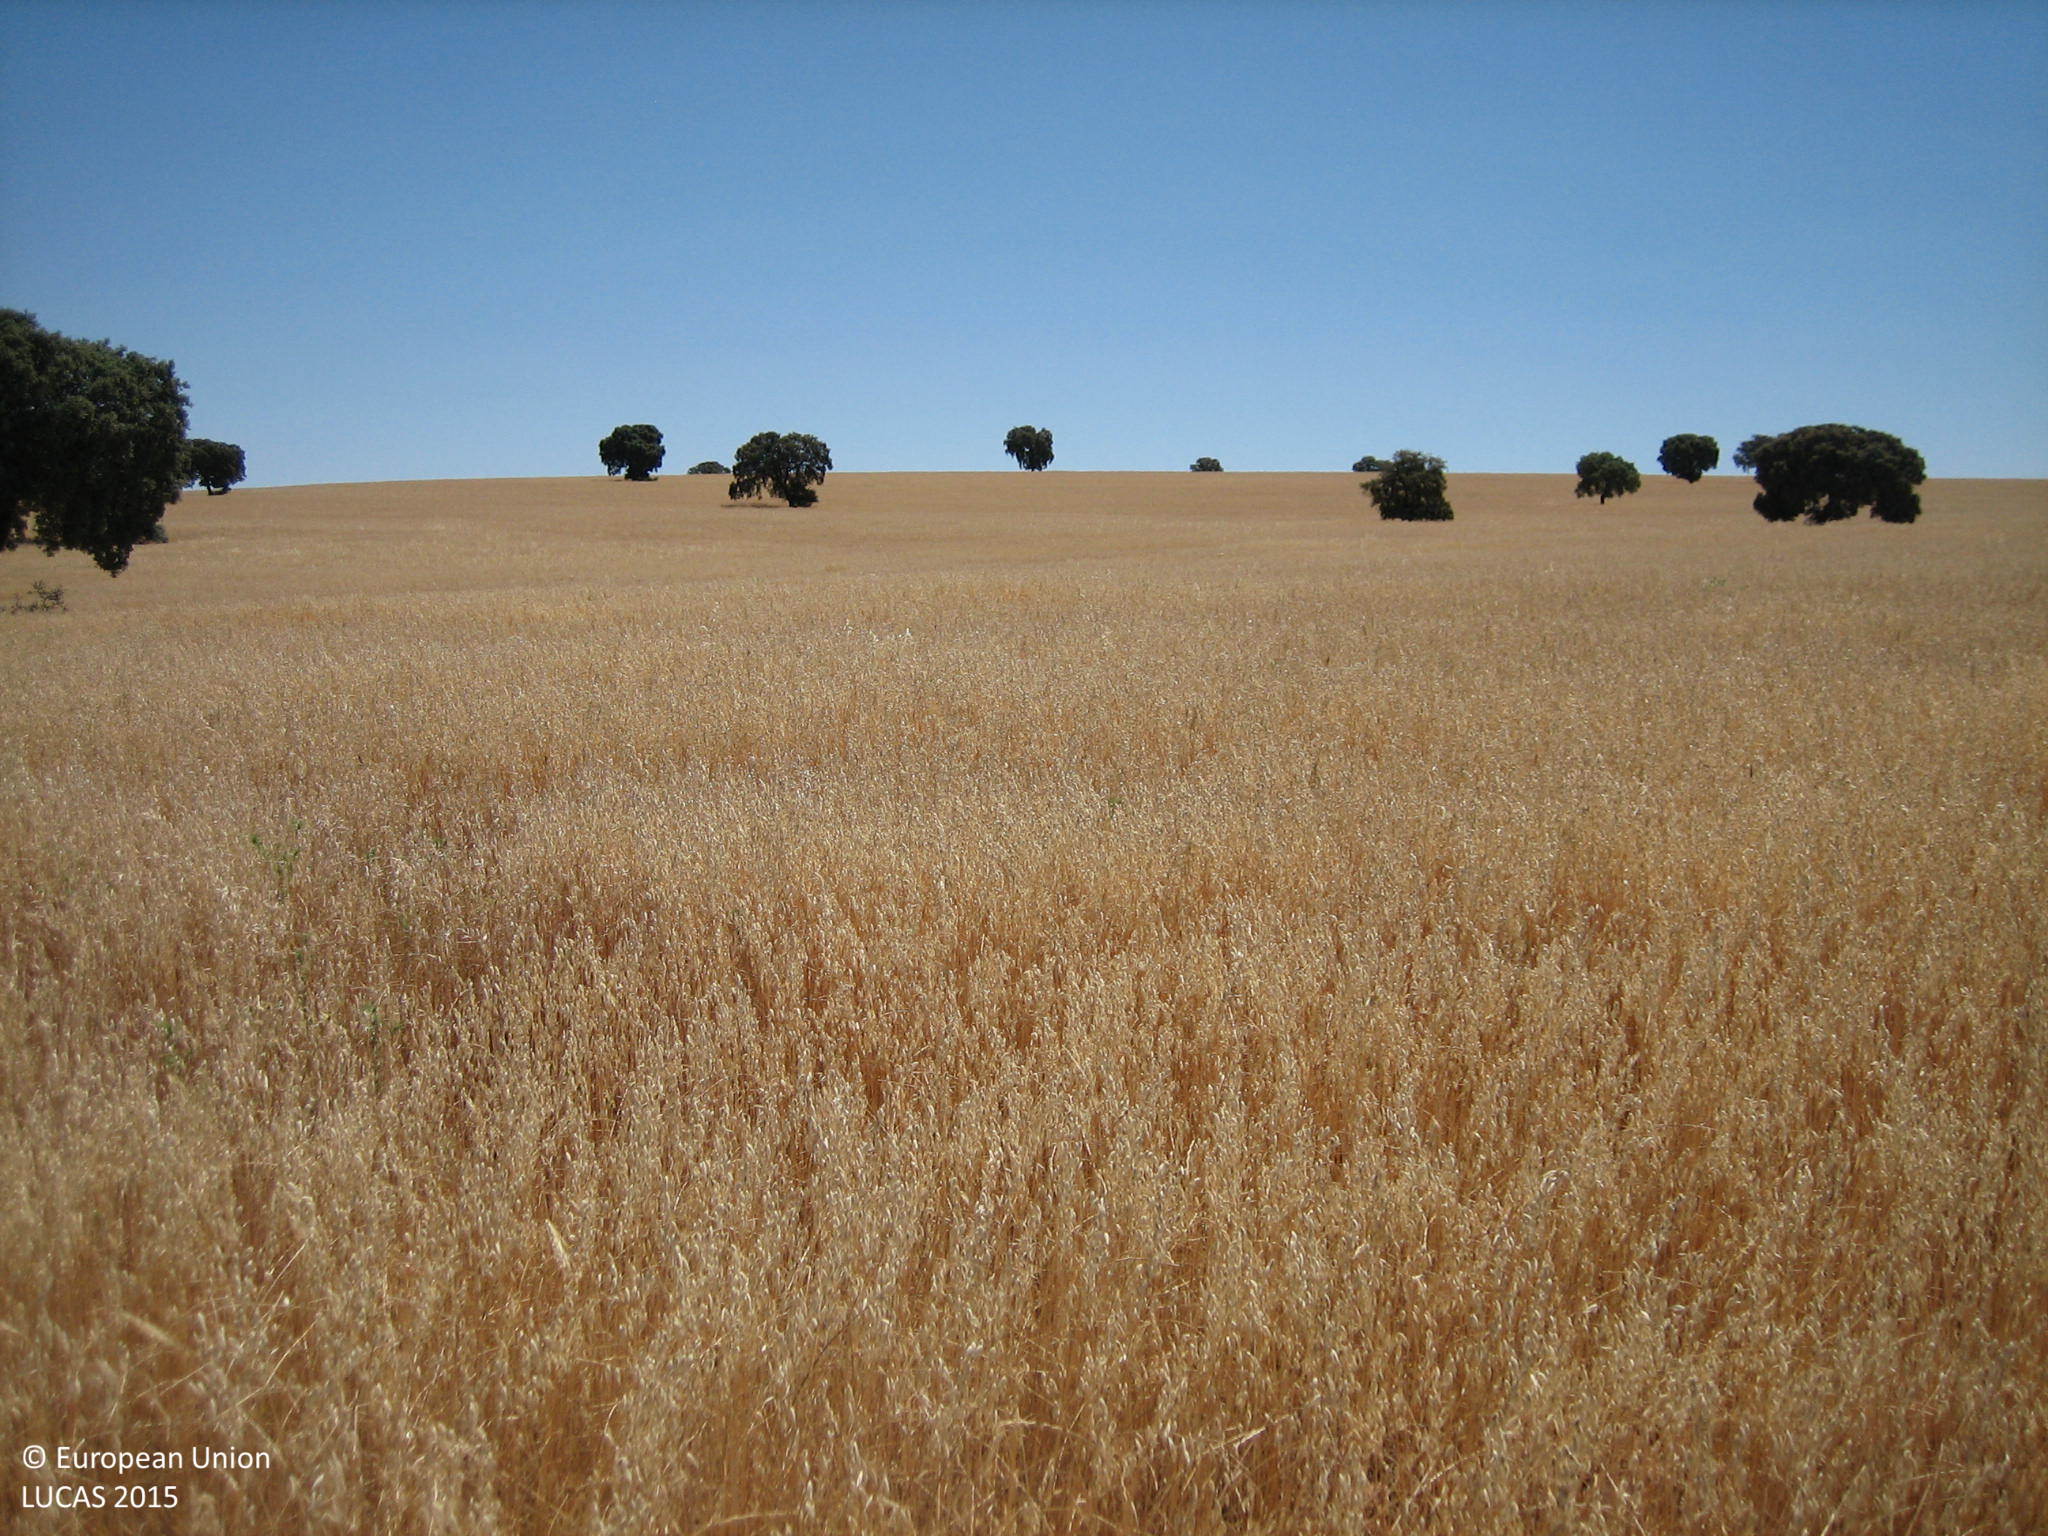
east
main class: Cropland
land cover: Oats
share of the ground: > 75 %
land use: Agriculture (excluding fallow land and kitchen gardens)
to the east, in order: Oats; Single bushes/trees; Oats; Single bushes/trees; Oats; Single bushes/trees; Oats
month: June
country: ES
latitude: 38.7916
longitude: -4.0535
